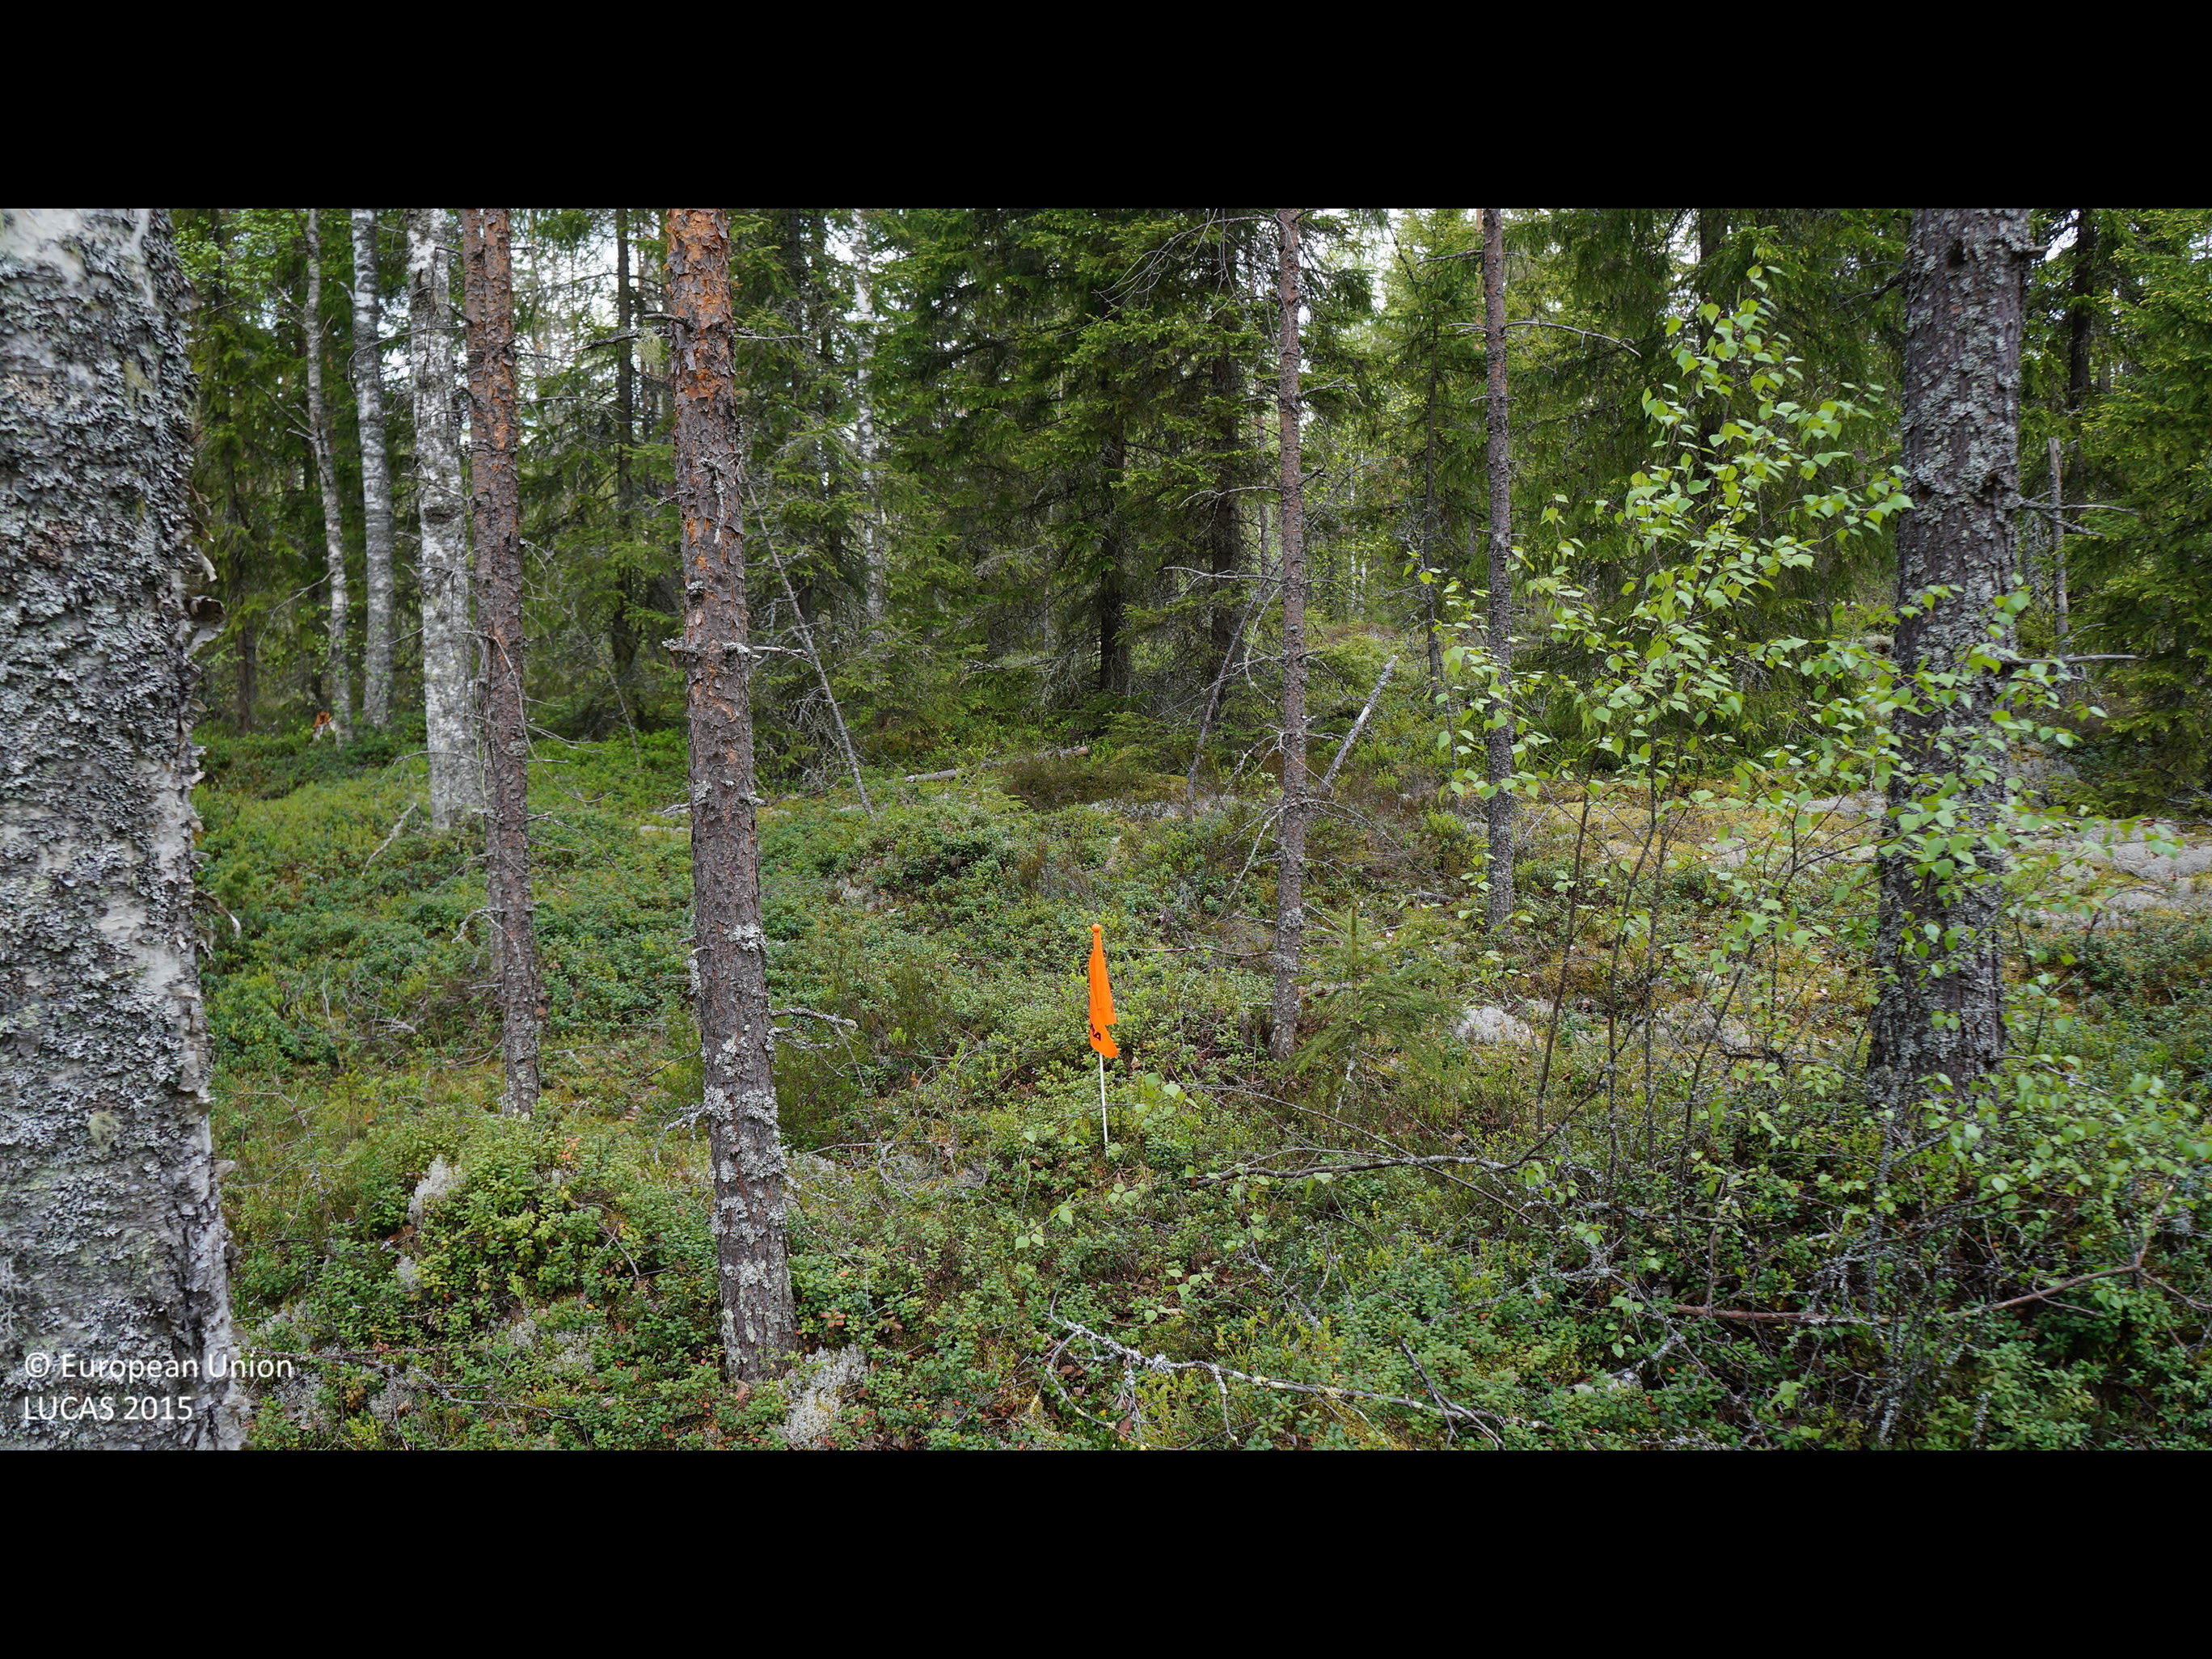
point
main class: Woodland
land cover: Pine dominated mixed woodland
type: boreal forest
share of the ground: 50 - 75 %
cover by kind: coniferous forest trees 40 %, shrubs 25 %, broadleaved forest trees 20 %, lichens and mosses 15 %
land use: Forestry
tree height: > 5 m
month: June
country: FI
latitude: 63.8045
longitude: 24.2649
